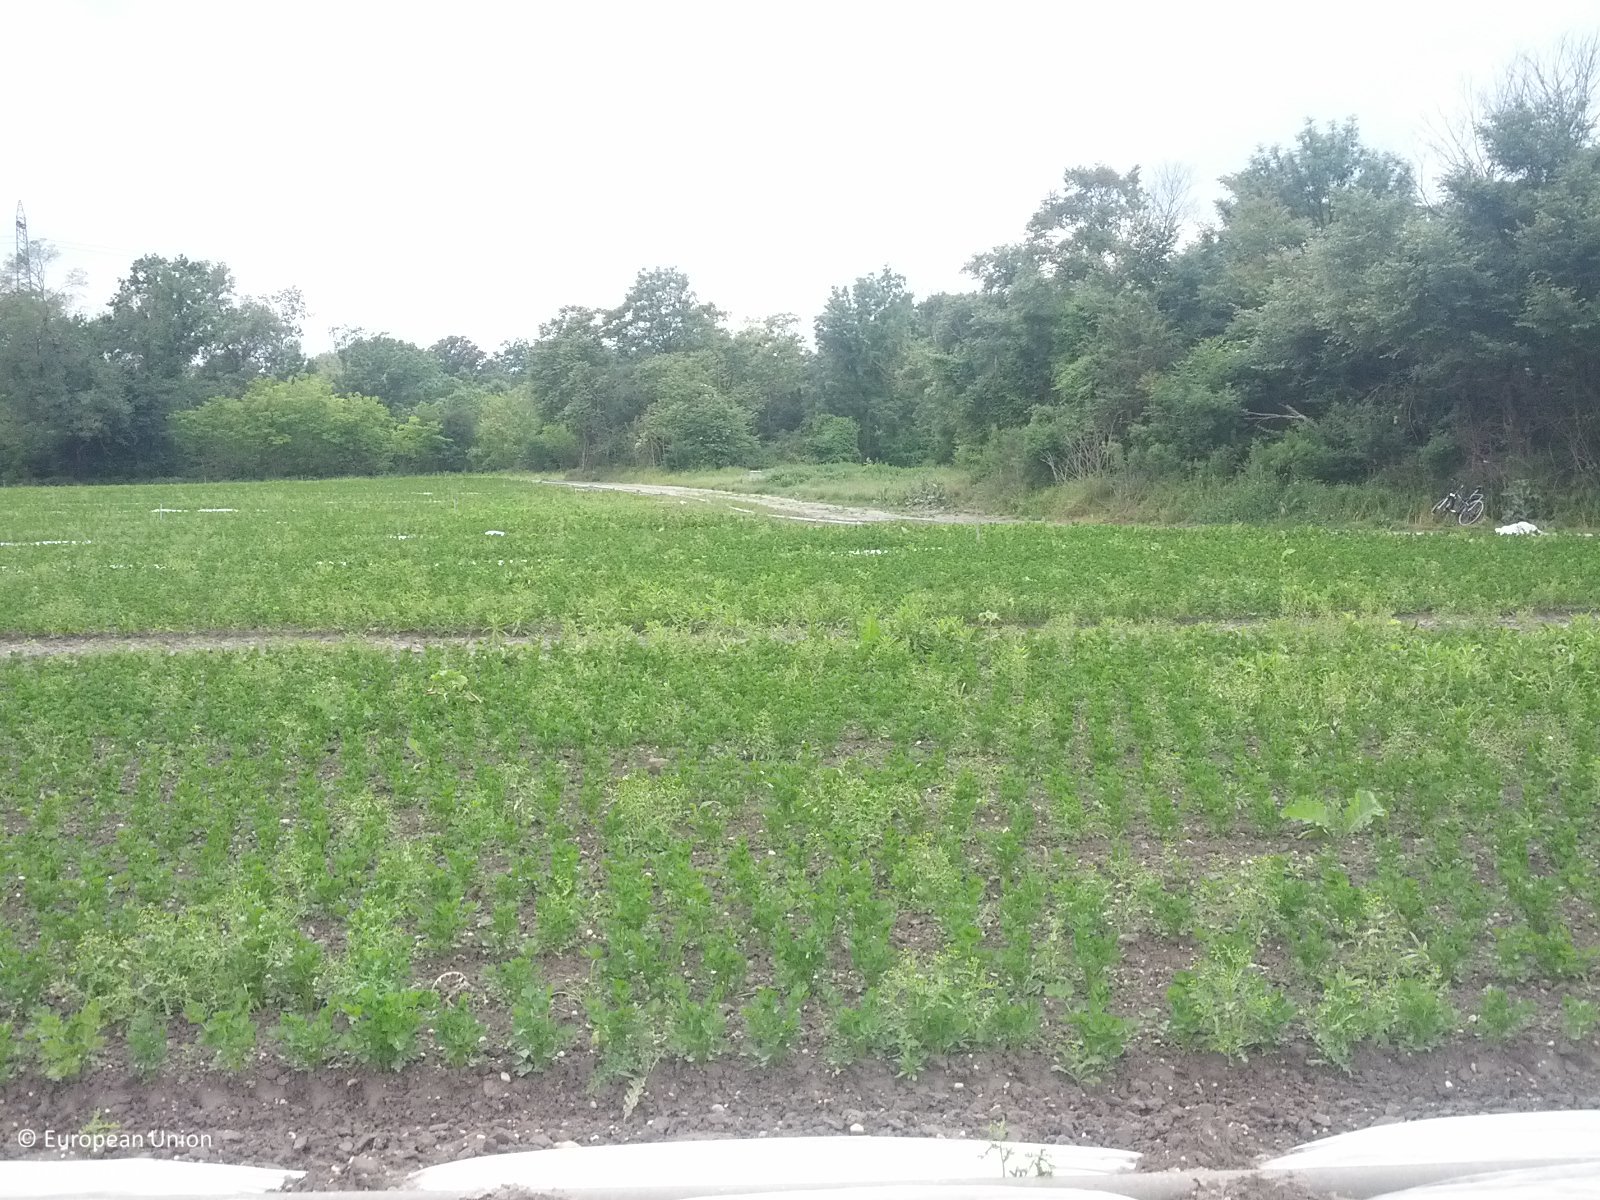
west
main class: Cropland
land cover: Other fresh vegetables
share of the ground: 25 - 50 %
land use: Agriculture (excluding fallow land and kitchen gardens)
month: May
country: AT
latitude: 48.1940
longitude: 16.5033
